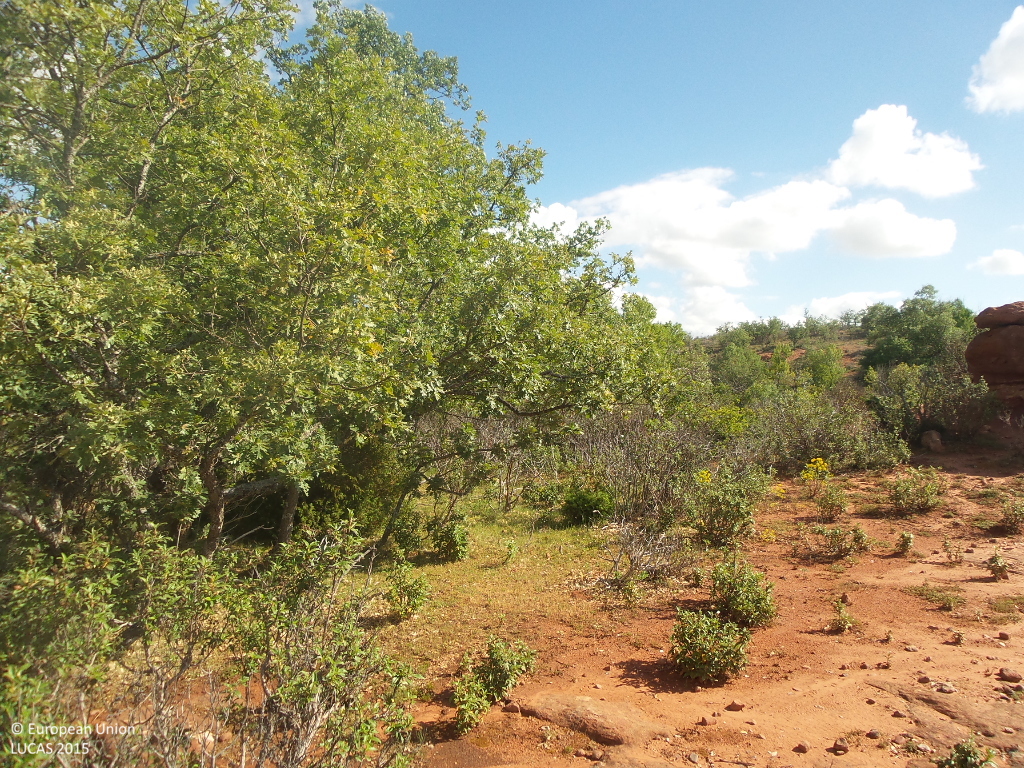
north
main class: Shrubland
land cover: Shrubland with sparse tree cover
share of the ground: 50 - 75 %
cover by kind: shrubs 50 %, consolidated bare surface 30 %, lichens and mosses 10 %, broadleaved forest trees 5 %, unconsolidated bare surface 5 %
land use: Semi-natural and natural areas not in use
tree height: > 5 m
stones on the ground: 25 - 50 %
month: June
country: ES
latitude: 41.2947
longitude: -3.0444
